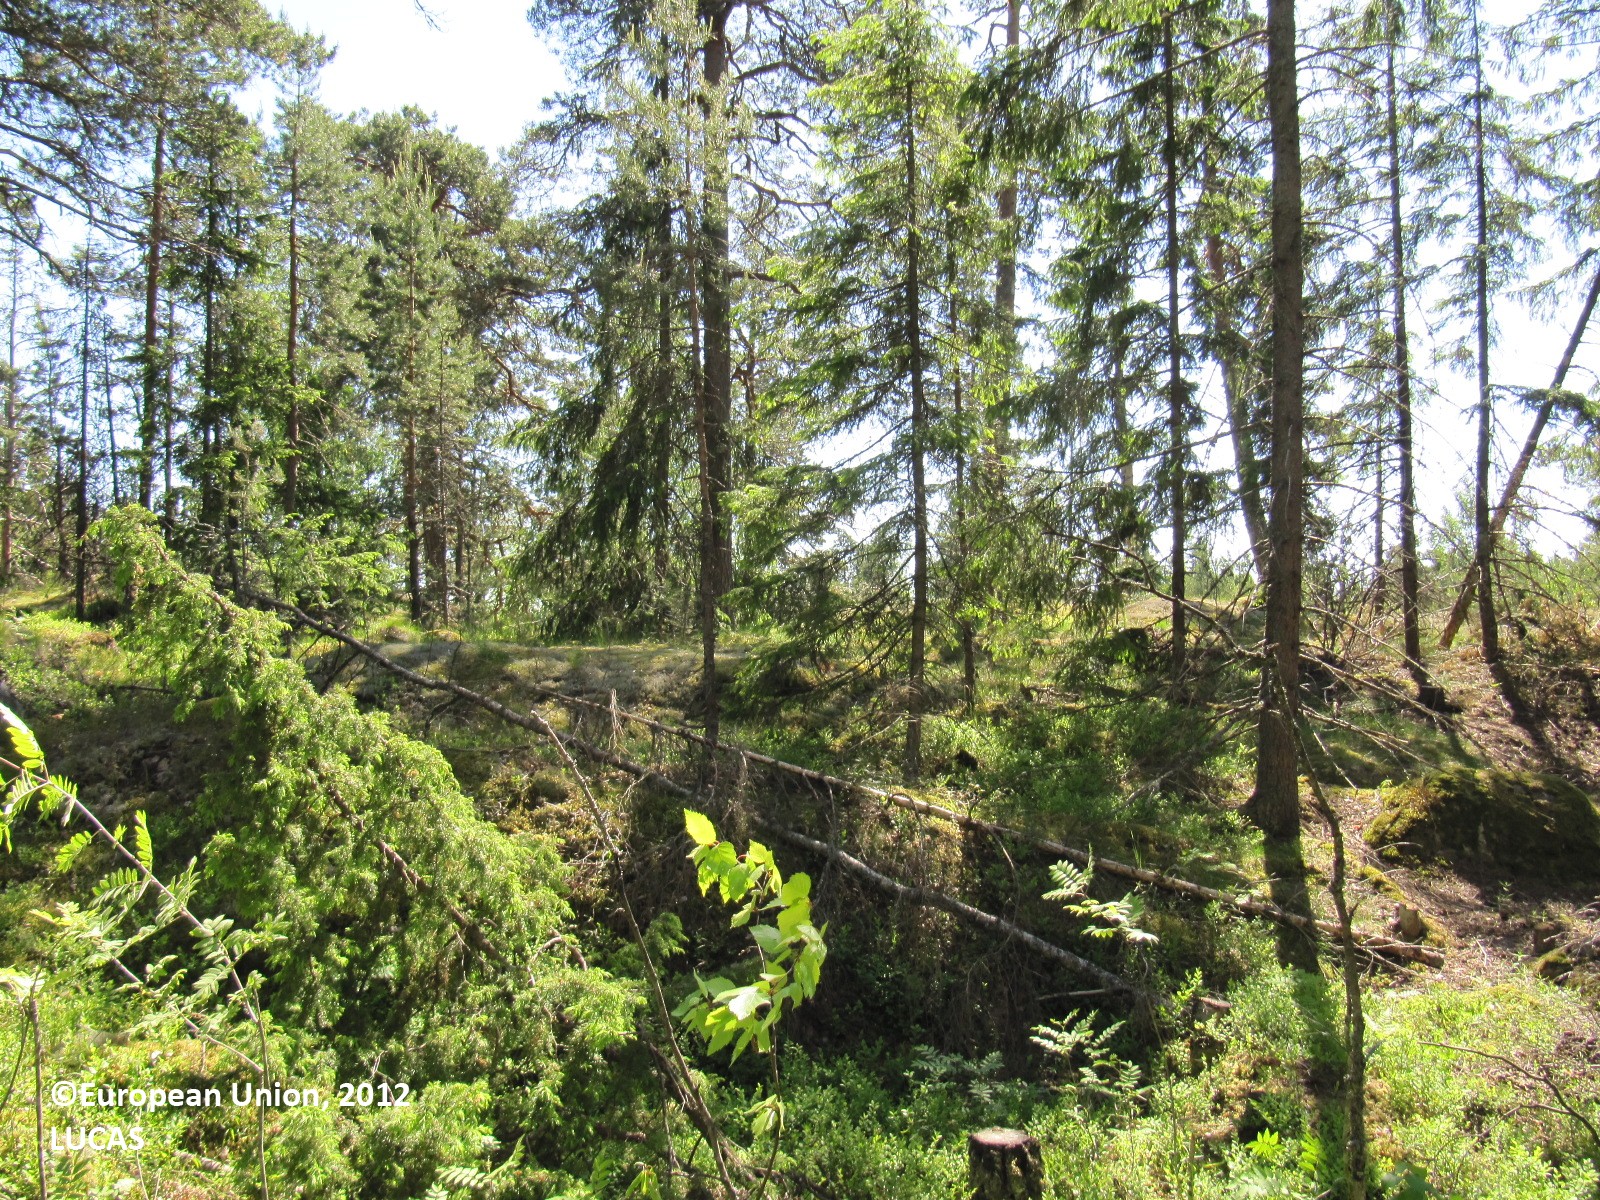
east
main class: Woodland
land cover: Pine dominated mixed woodland
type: boreal forest
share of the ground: 25 - 50 %
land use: Forestry
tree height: > 5 m
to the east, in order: Pine dominated mixed woodland; Rocks and stones; Pine dominated mixed woodland; Tracks; Other mixed woodland; Spruce dominated mixed woodland; Other mixed woodland; Spruce dominated mixed woodland
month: June
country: FI
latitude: 60.1495
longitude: 24.2424
